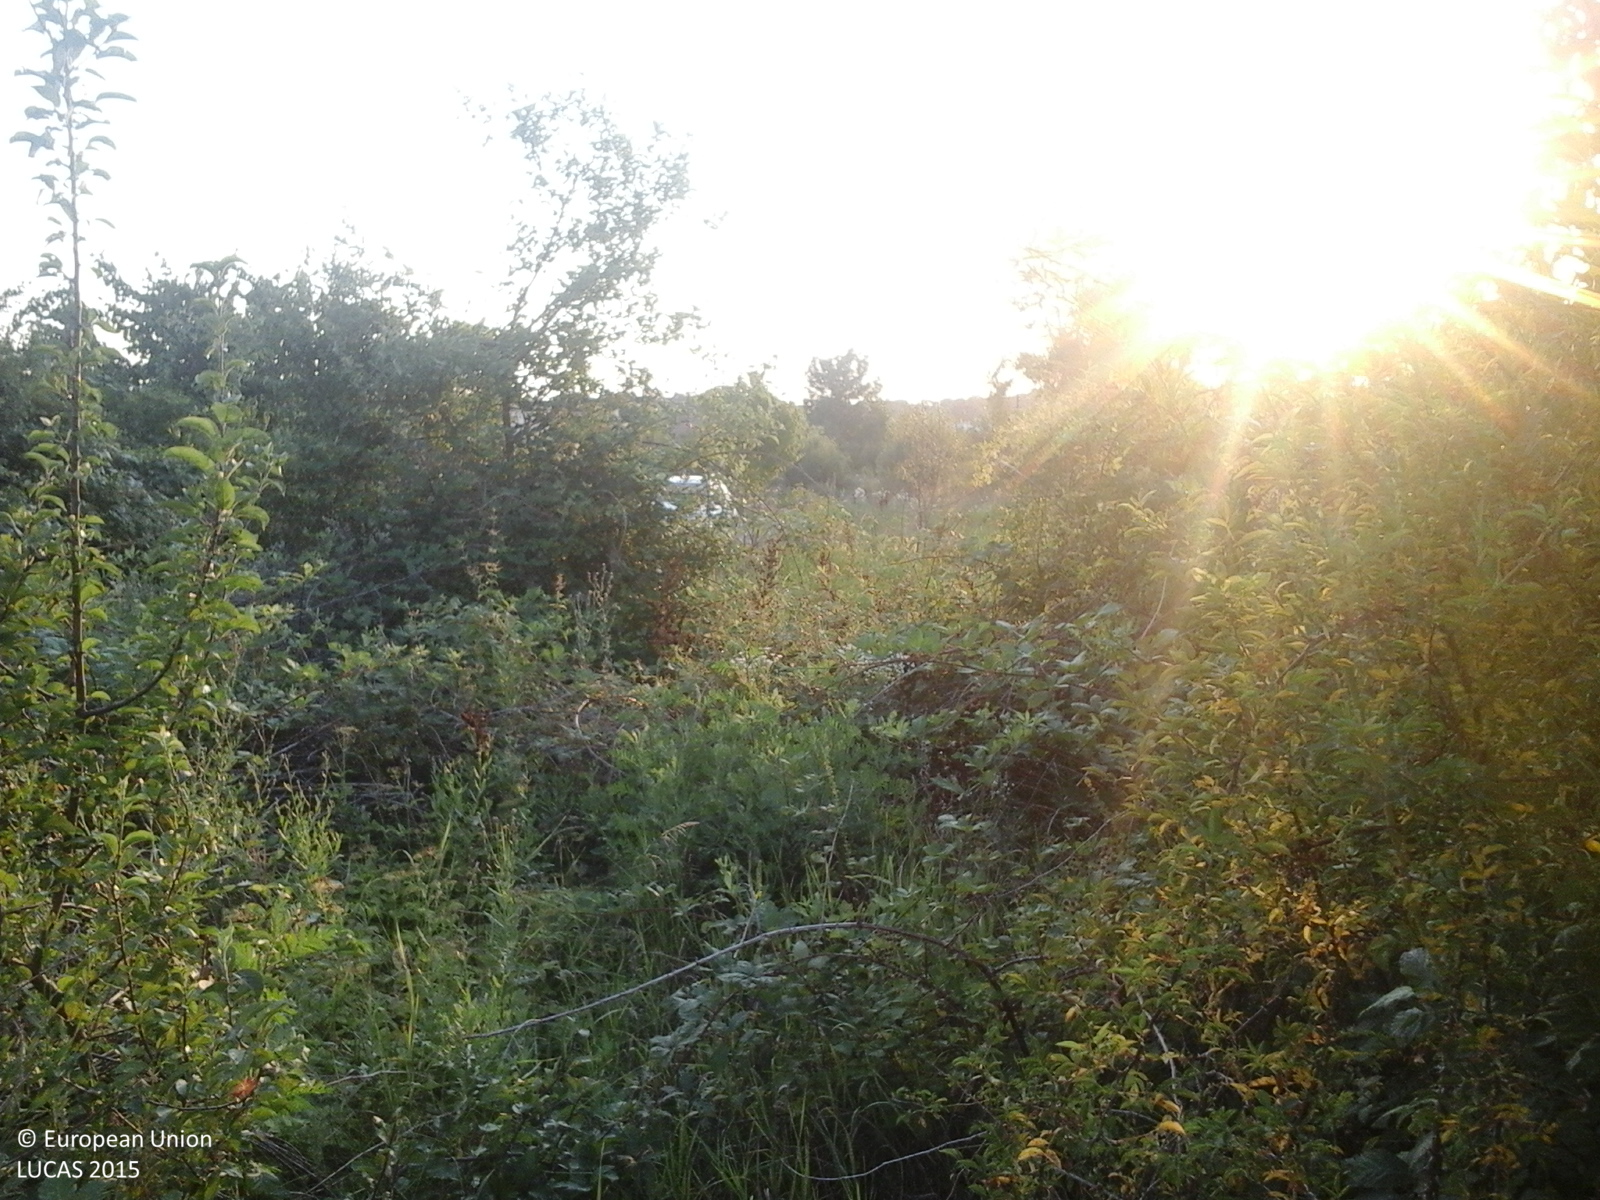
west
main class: Shrubland
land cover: Shrubland with sparse tree cover
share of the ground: > 75 %
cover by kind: shrubs 95 %, broadleaved forest trees 5 %
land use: Abandoned areas
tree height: > 5 m
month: July
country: RO
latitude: 44.8055
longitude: 25.4034
